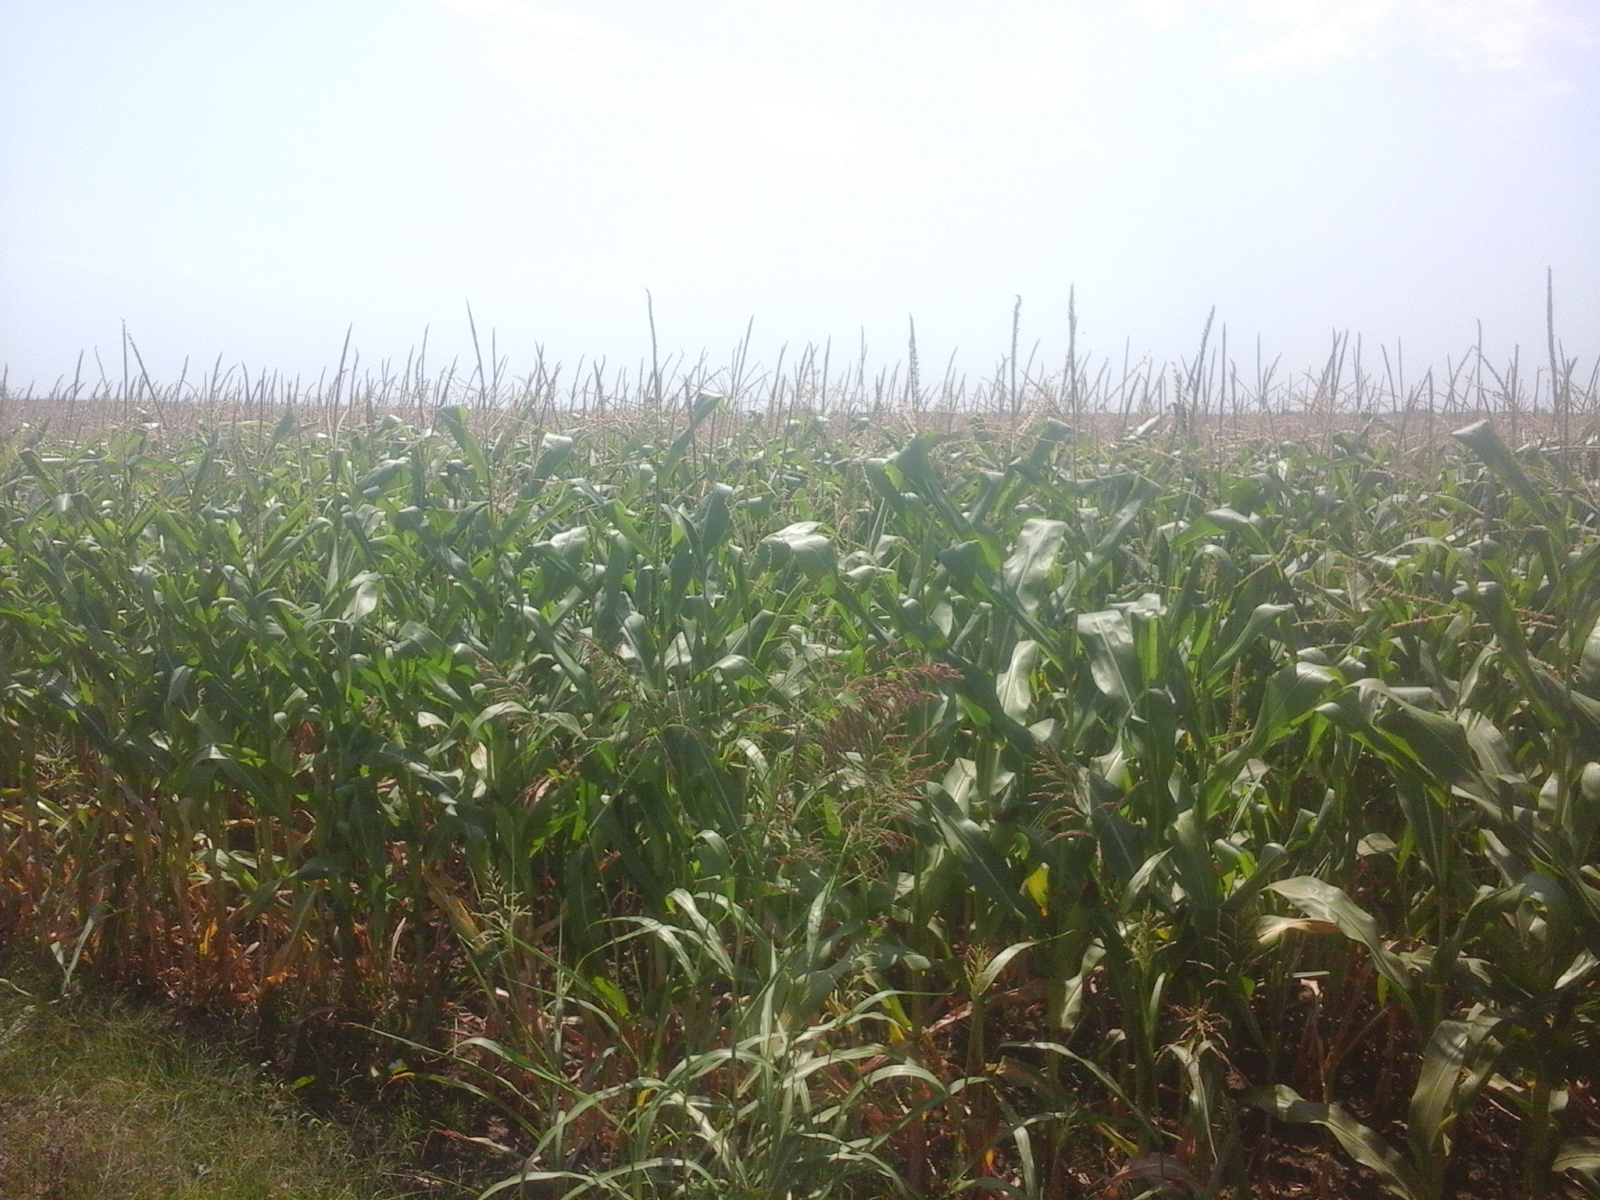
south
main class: Cropland
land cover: Maize
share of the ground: > 75 %
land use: Agriculture (excluding fallow land and kitchen gardens)
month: August
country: RO
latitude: 45.0508
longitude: 27.7678
